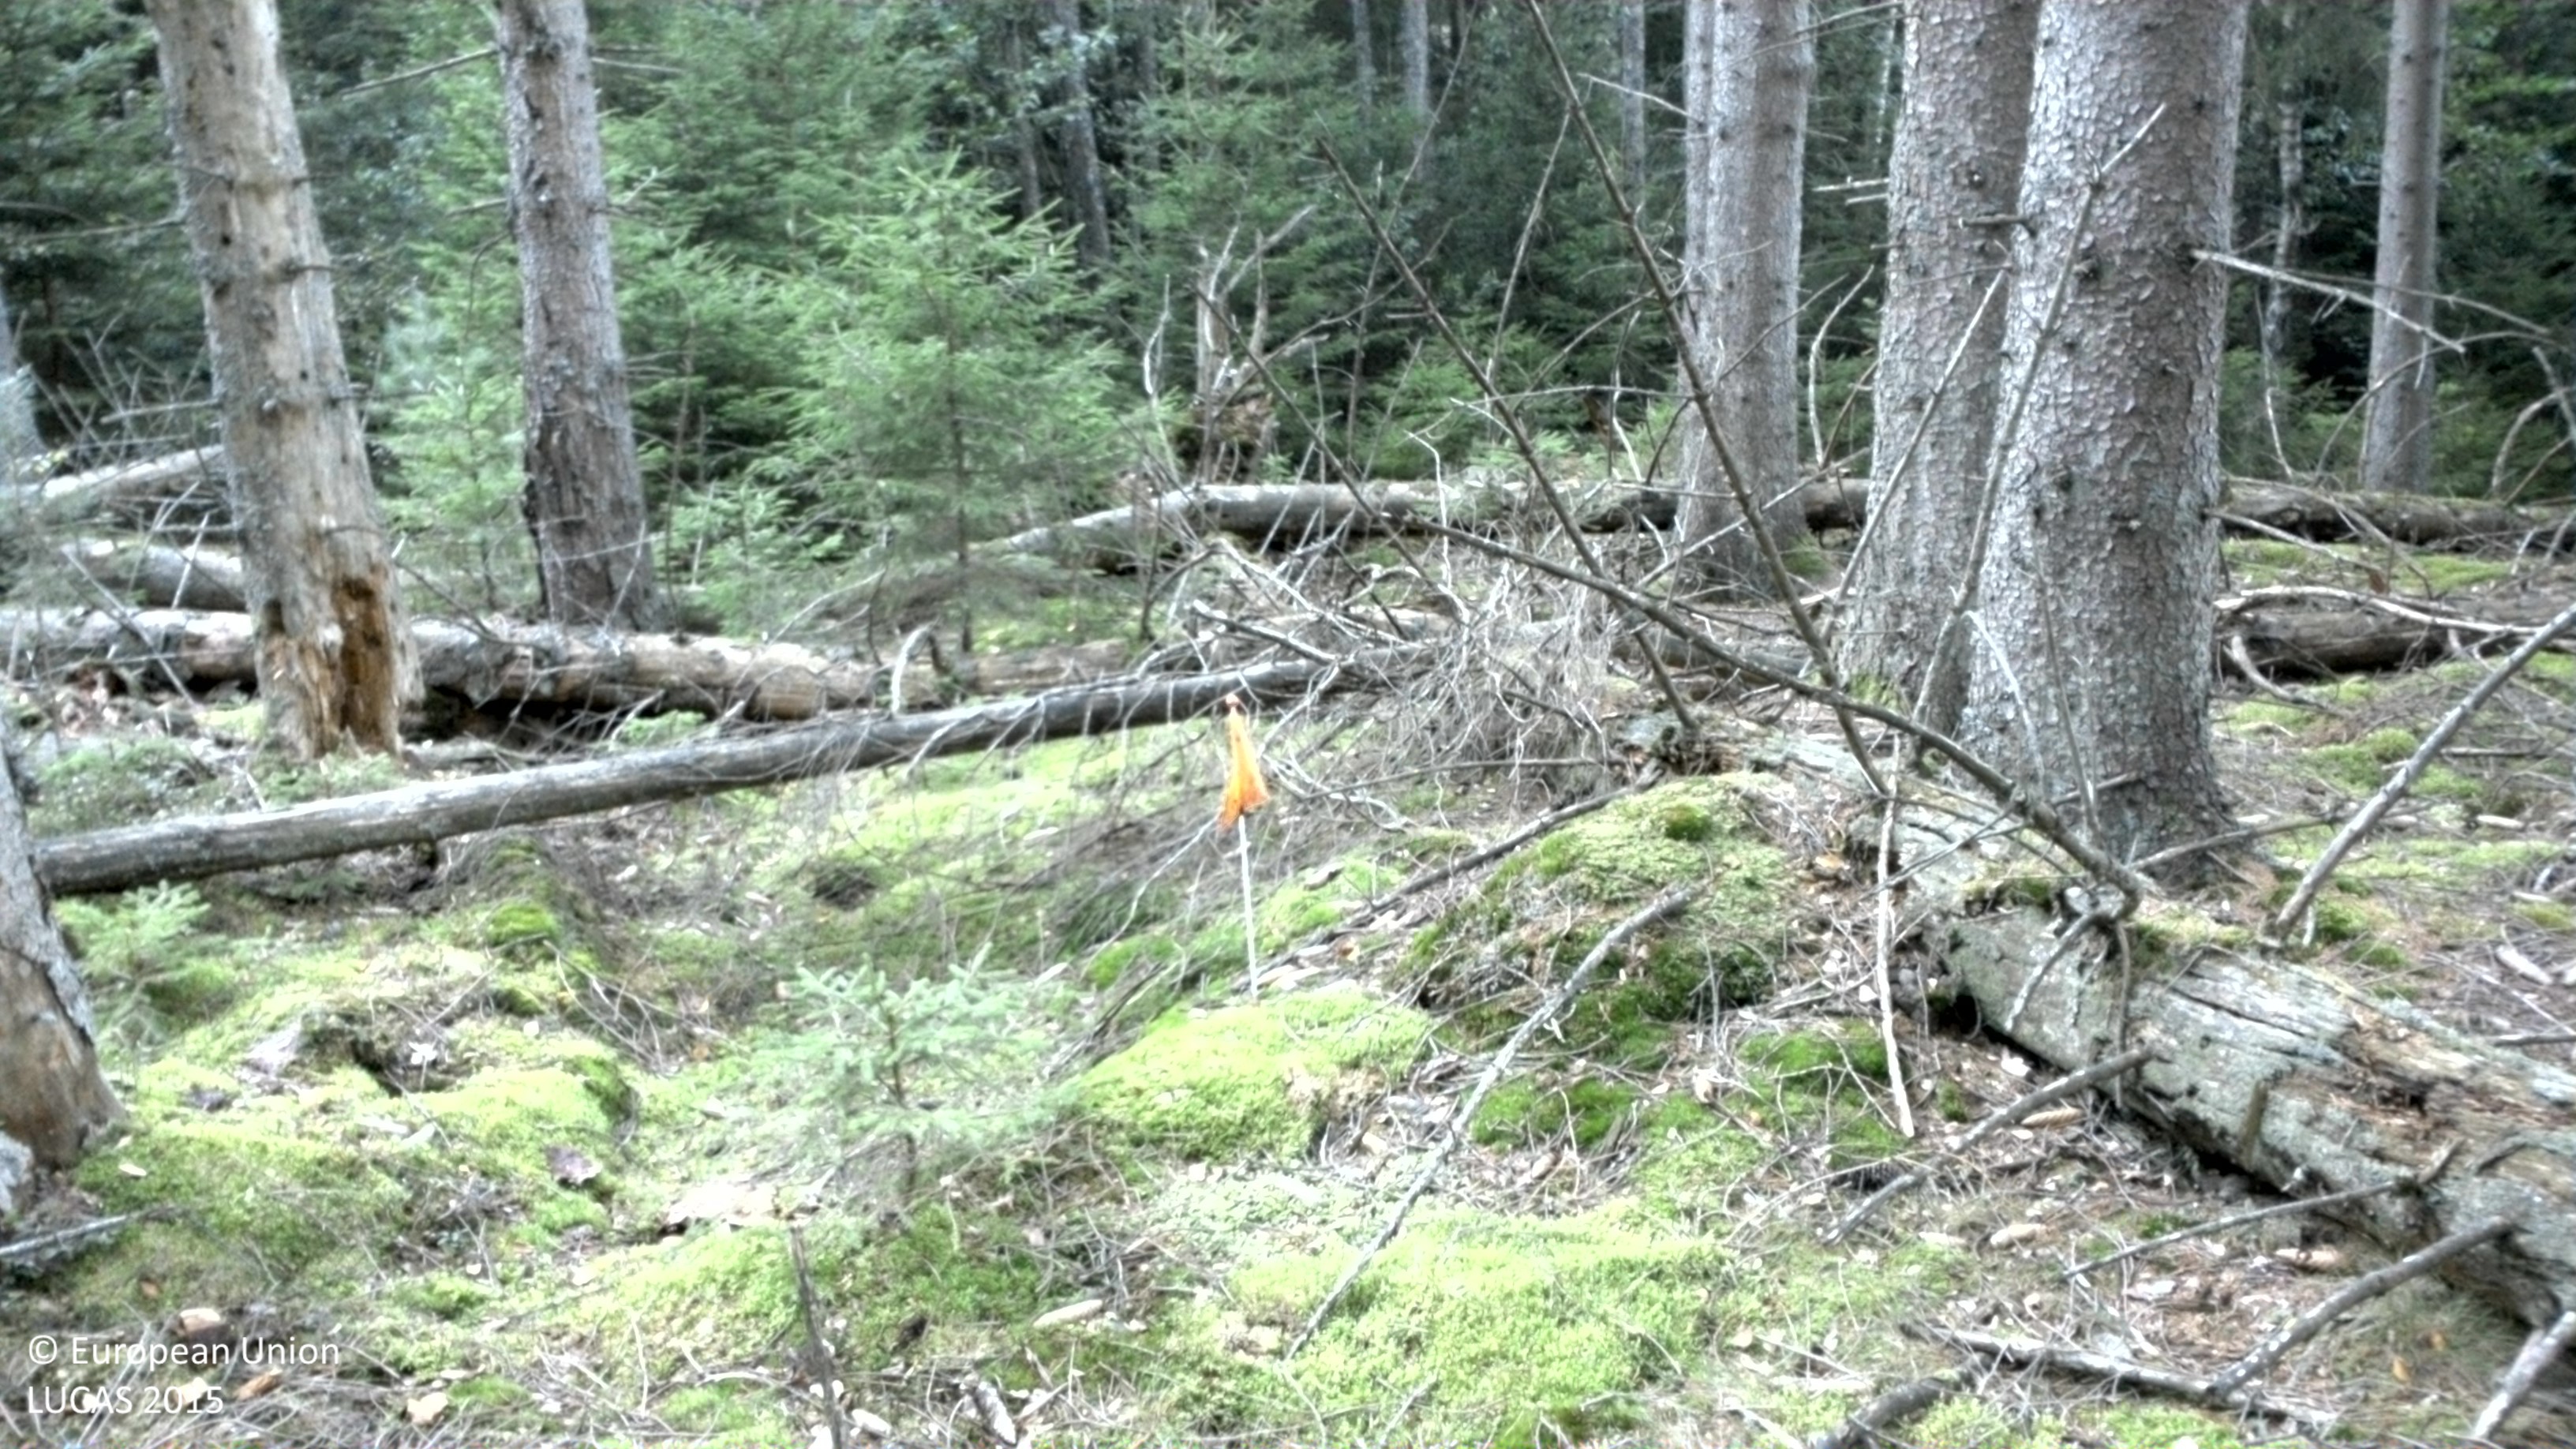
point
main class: Woodland
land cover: Spruce dominated coniferous woodland
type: boreal forest
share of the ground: > 75 %
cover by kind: coniferous forest trees 75 %, lichens and mosses 25 %
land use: Forestry
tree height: > 5 m
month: September
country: SE
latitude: 56.2394
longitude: 14.3703
